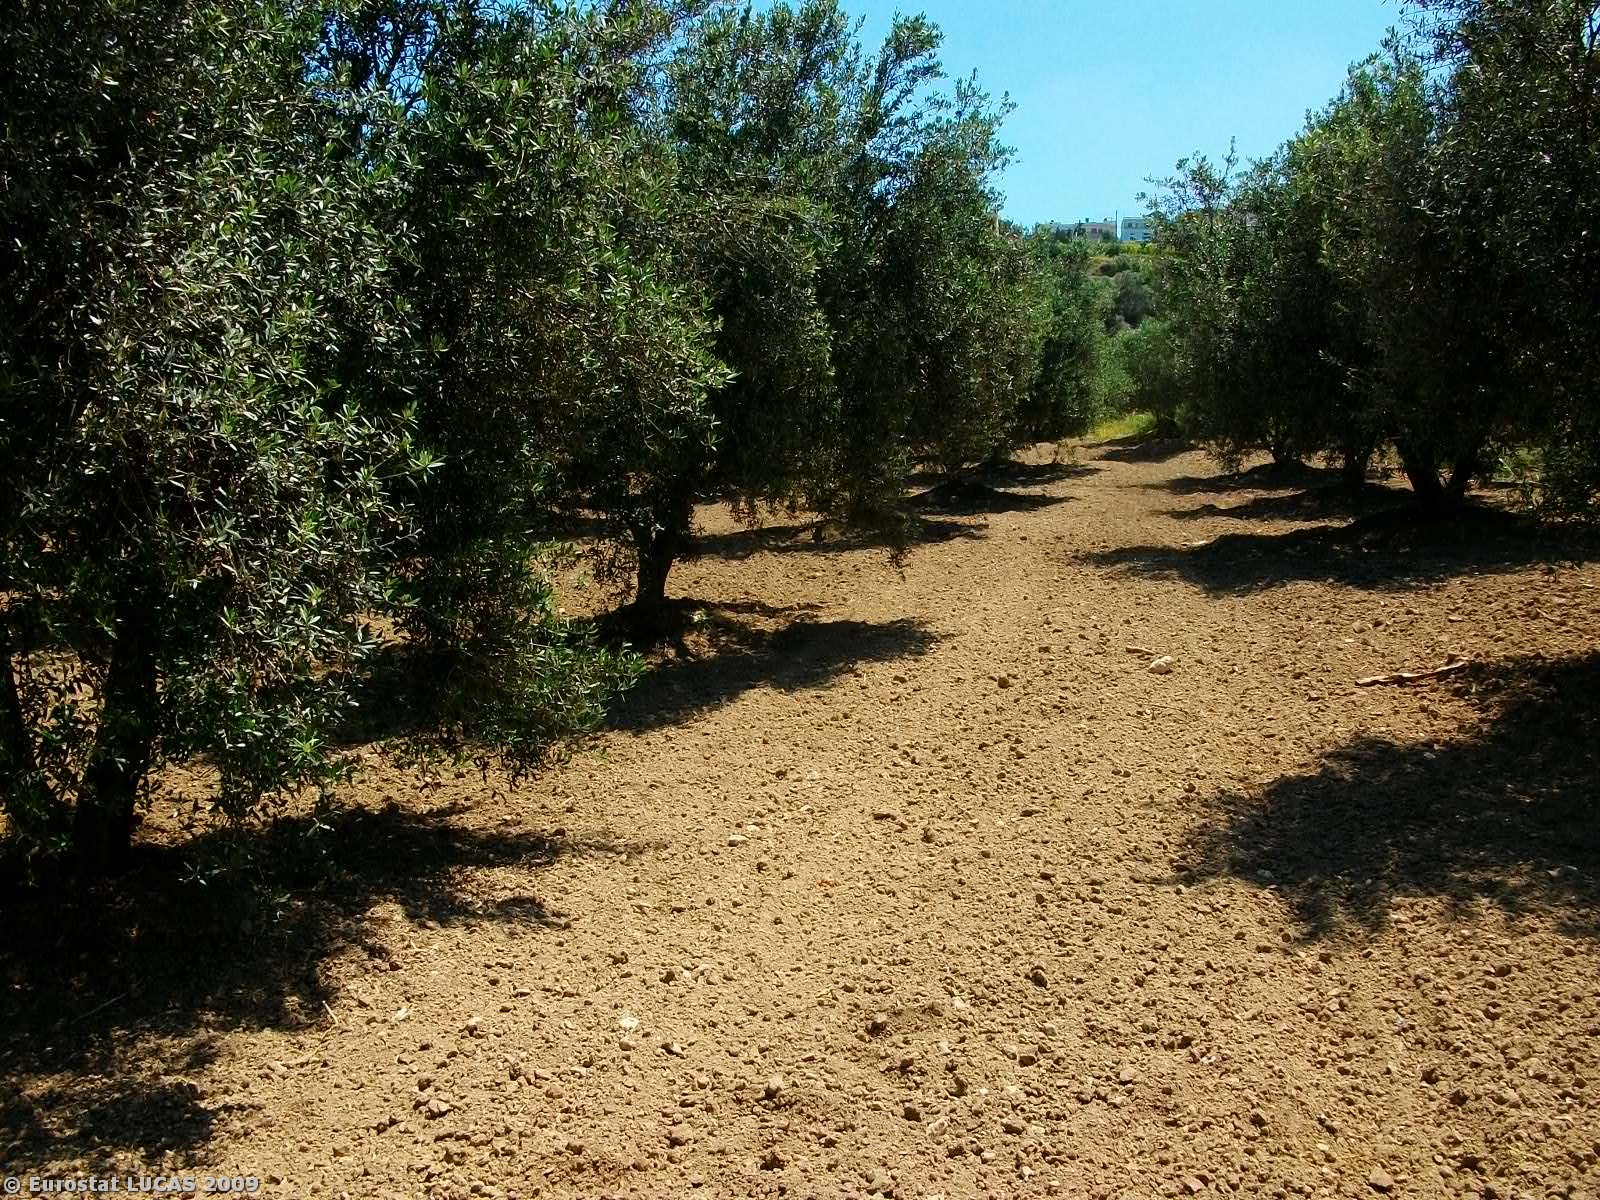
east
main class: Cropland
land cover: Olive groves
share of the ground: 50 - 75 %
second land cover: Bare land
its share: > 75 %
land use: Agriculture (excluding fallow land and kitchen gardens)
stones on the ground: < 10 %
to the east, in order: Olive groves; Bare land; Vineyards; Bare land; Paved roads, cycling and walking lanes; Olive groves; Bare land; Olive groves; Bare land; Shrubland with sparse tree cover; Olive groves; Vineyards; Bare land
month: May
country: GR
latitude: 35.2084
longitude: 25.0942
